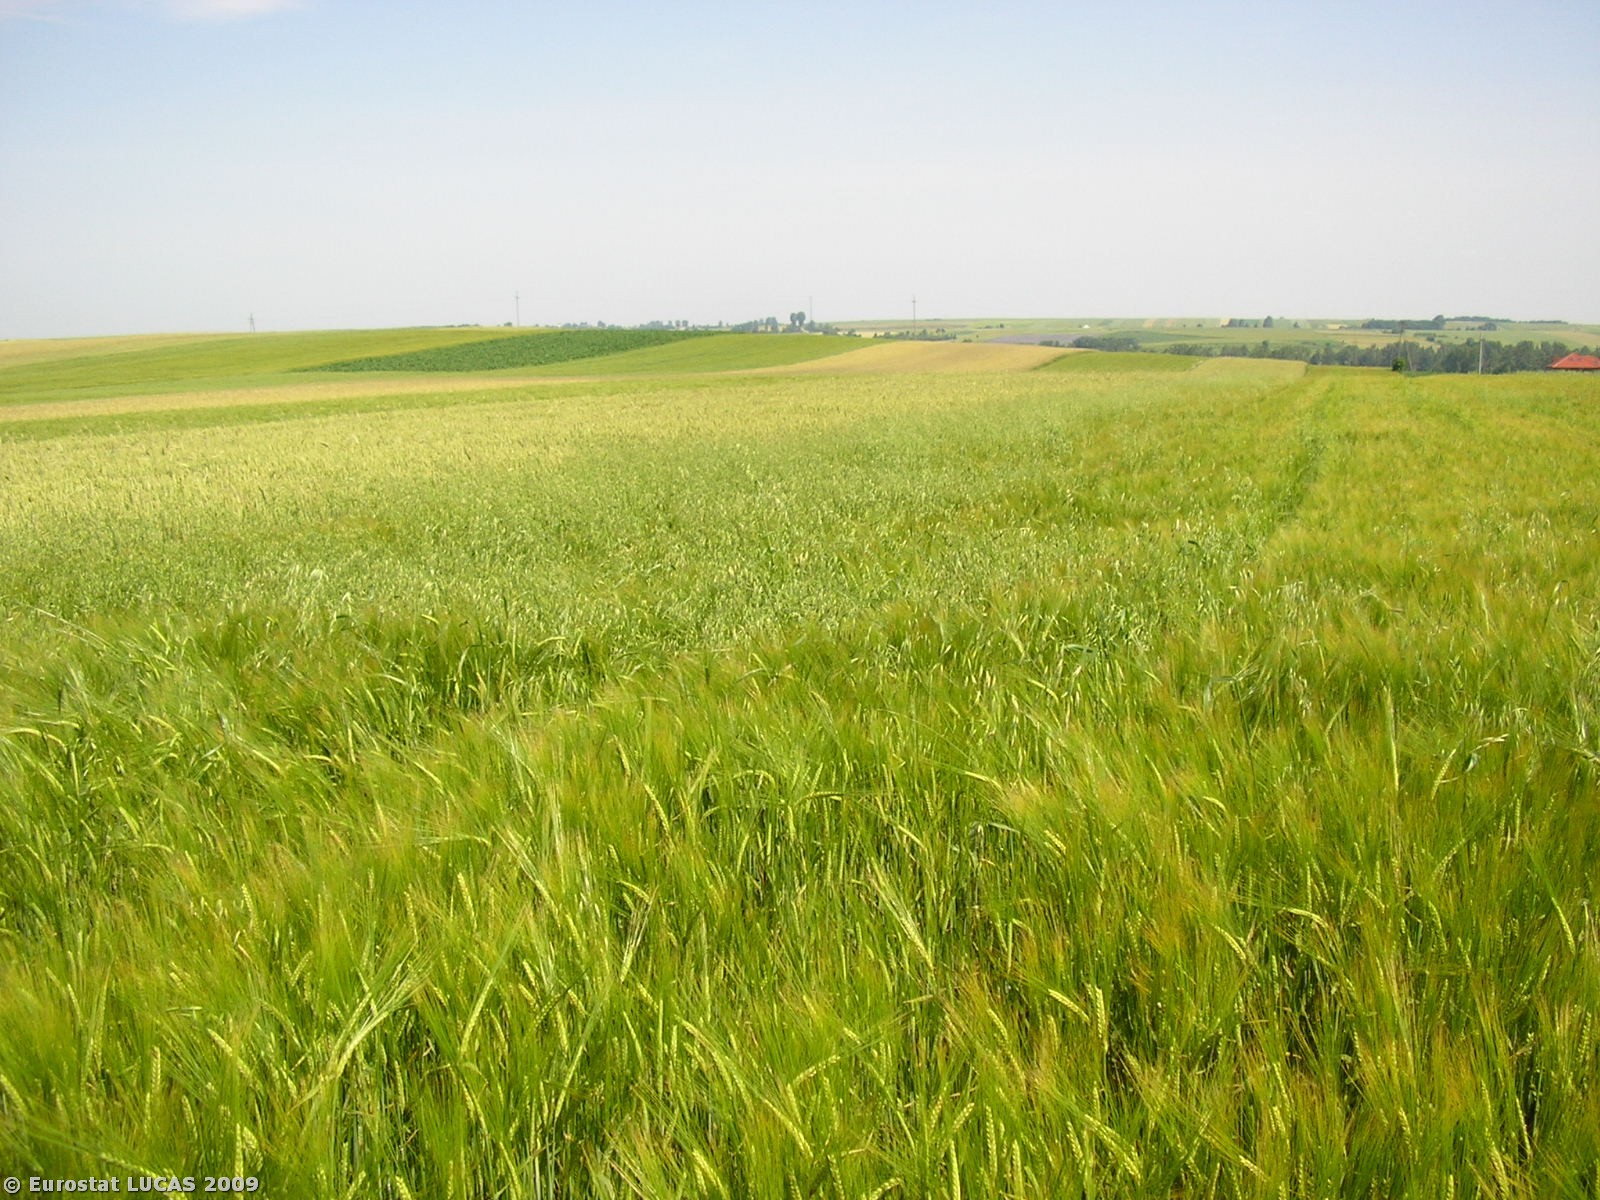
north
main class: Cropland
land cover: Barley
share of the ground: > 75 %
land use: Agriculture (excluding fallow land and kitchen gardens)
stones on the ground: < 10 %
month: June
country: PL
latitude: 50.3705
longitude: 20.2851
